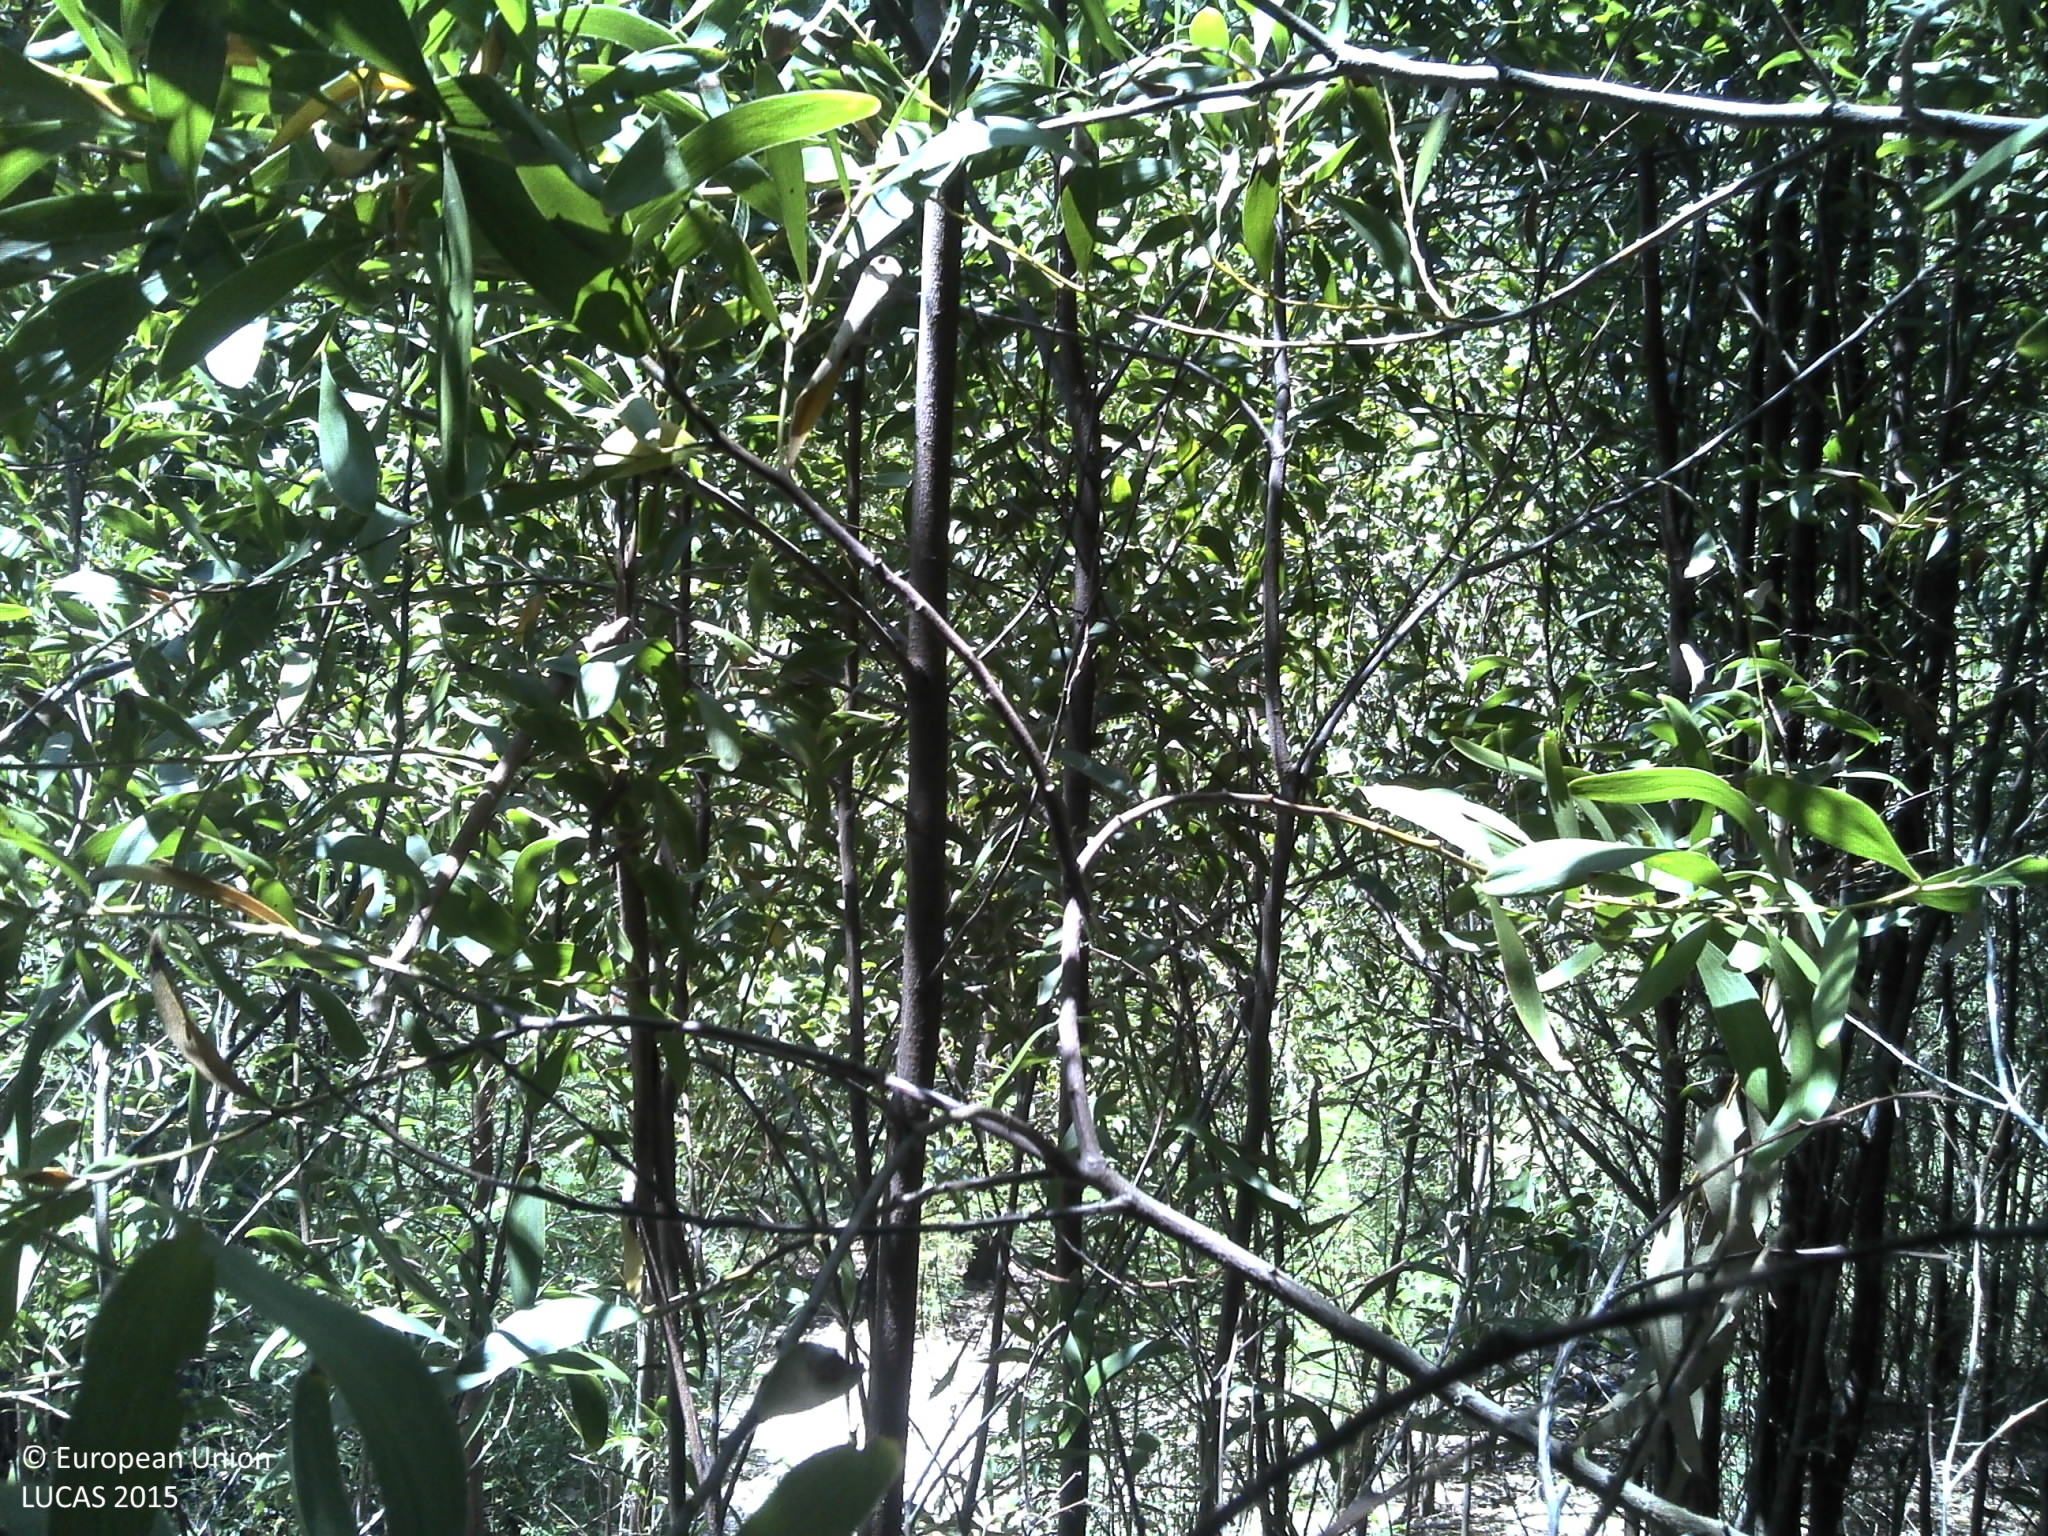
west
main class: Woodland
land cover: Broadleaved woodland
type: exotic forest
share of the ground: > 75 %
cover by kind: broadleaved forest trees 80 %, shrubs 10 %, herbaceous plants 5 %, unconsolidated bare surface 5 %
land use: Forestry
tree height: > 5 m
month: May
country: PT
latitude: 40.5131
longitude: -8.6602
